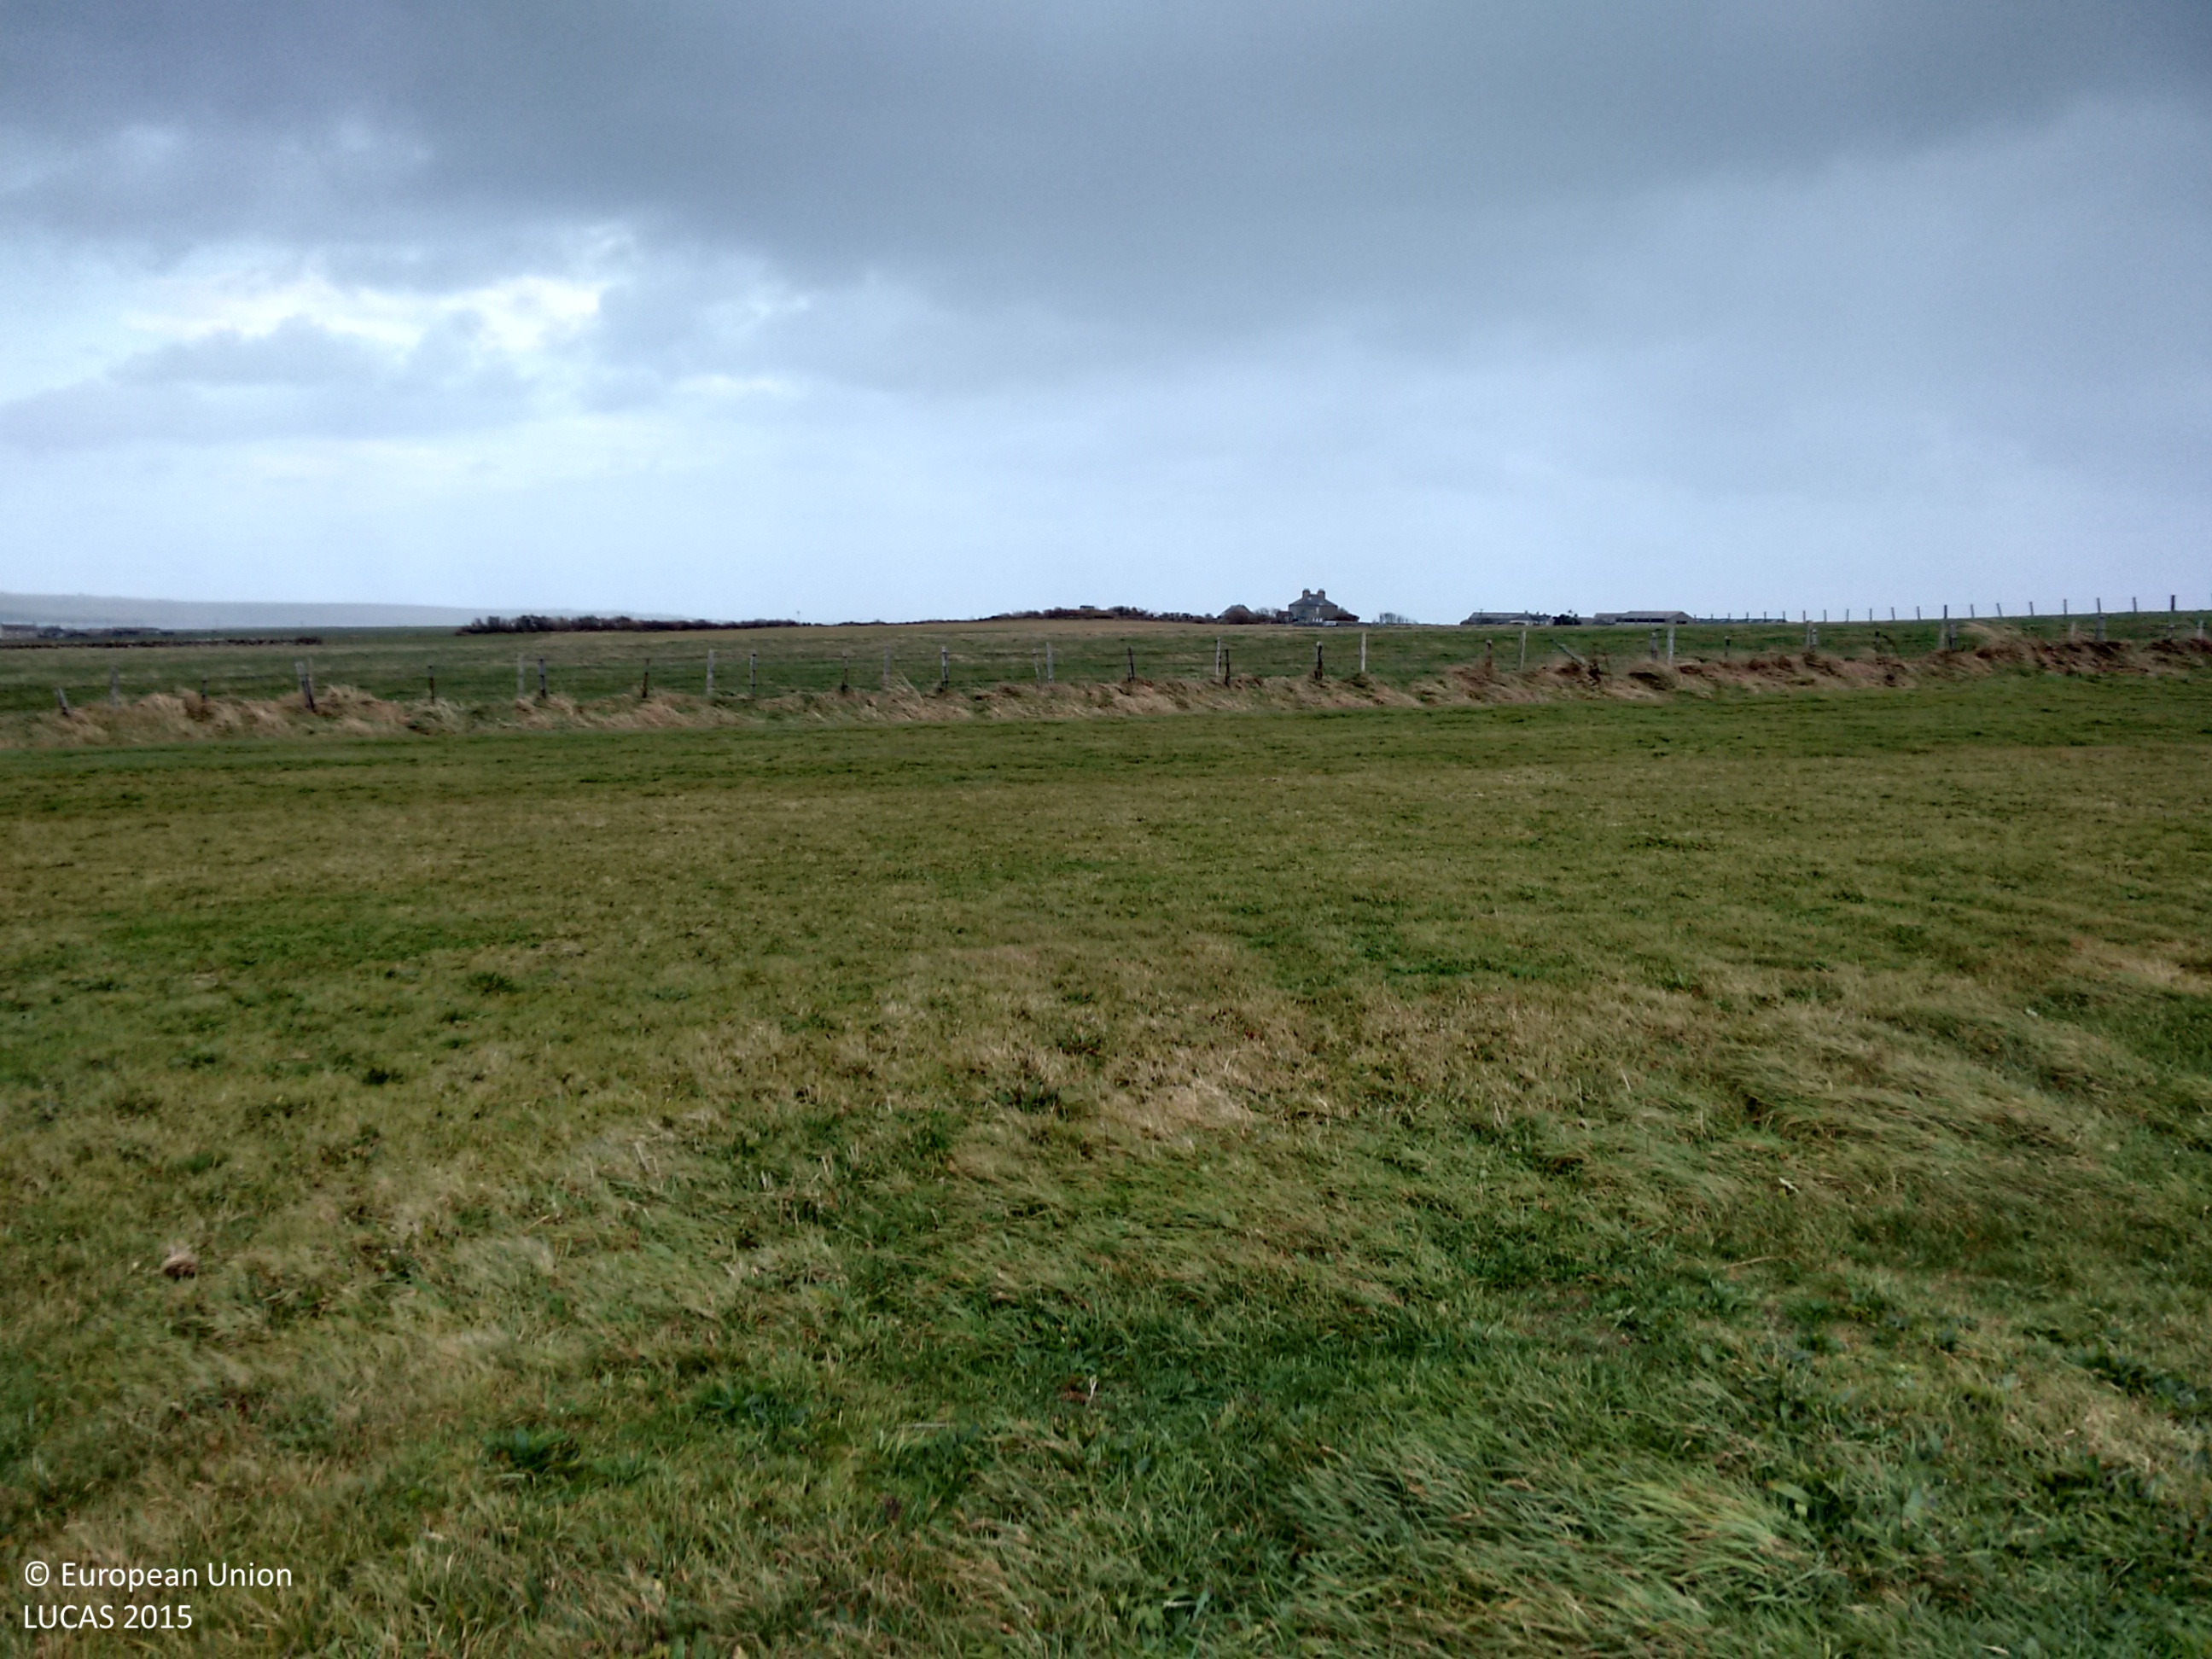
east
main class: Grassland
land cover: Grassland without tree/shrub cover
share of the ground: > 75 %
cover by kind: herbaceous plants 100 %
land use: Agriculture (excluding fallow land and kitchen gardens)
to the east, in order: Grassland without tree/shrub cover; Fences; Grass margins; Fences; Grassland without tree/shrub cover; Fences; Dry stone walls; Fences; Grassland without tree/shrub cover
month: November
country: GB
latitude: 58.9493
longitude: -2.8608
